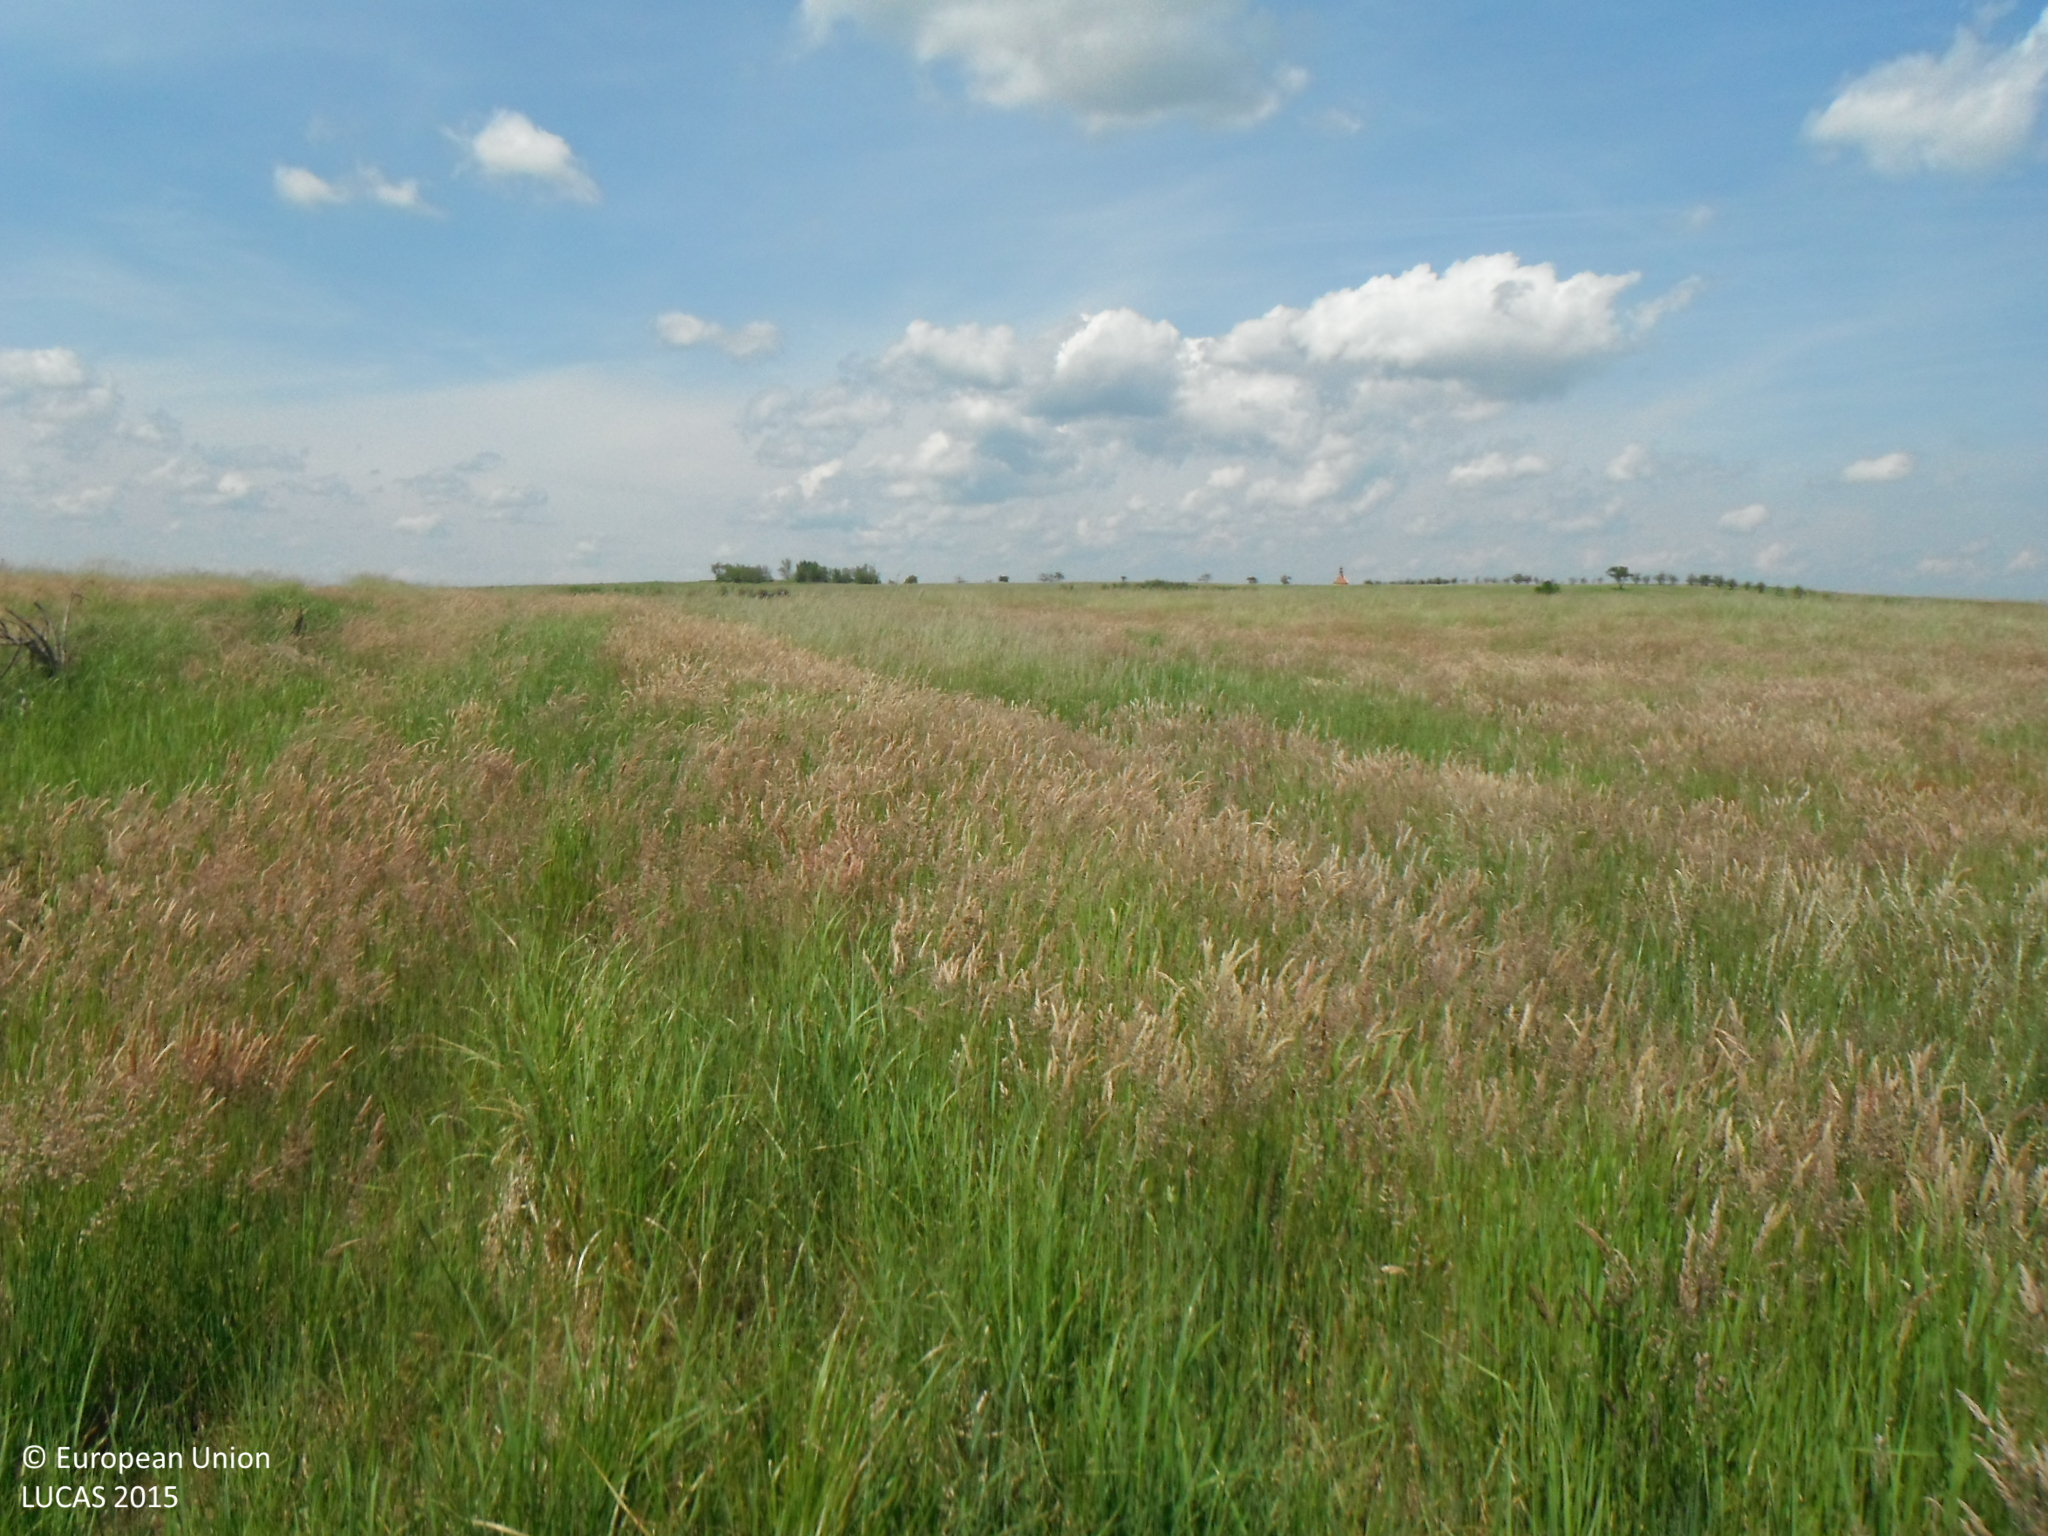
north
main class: Grassland
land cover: Grassland without tree/shrub cover
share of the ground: > 75 %
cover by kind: herbaceous plants 100 %
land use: Agriculture (excluding fallow land and kitchen gardens)
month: June
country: SK
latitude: 48.5940
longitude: 17.0455
